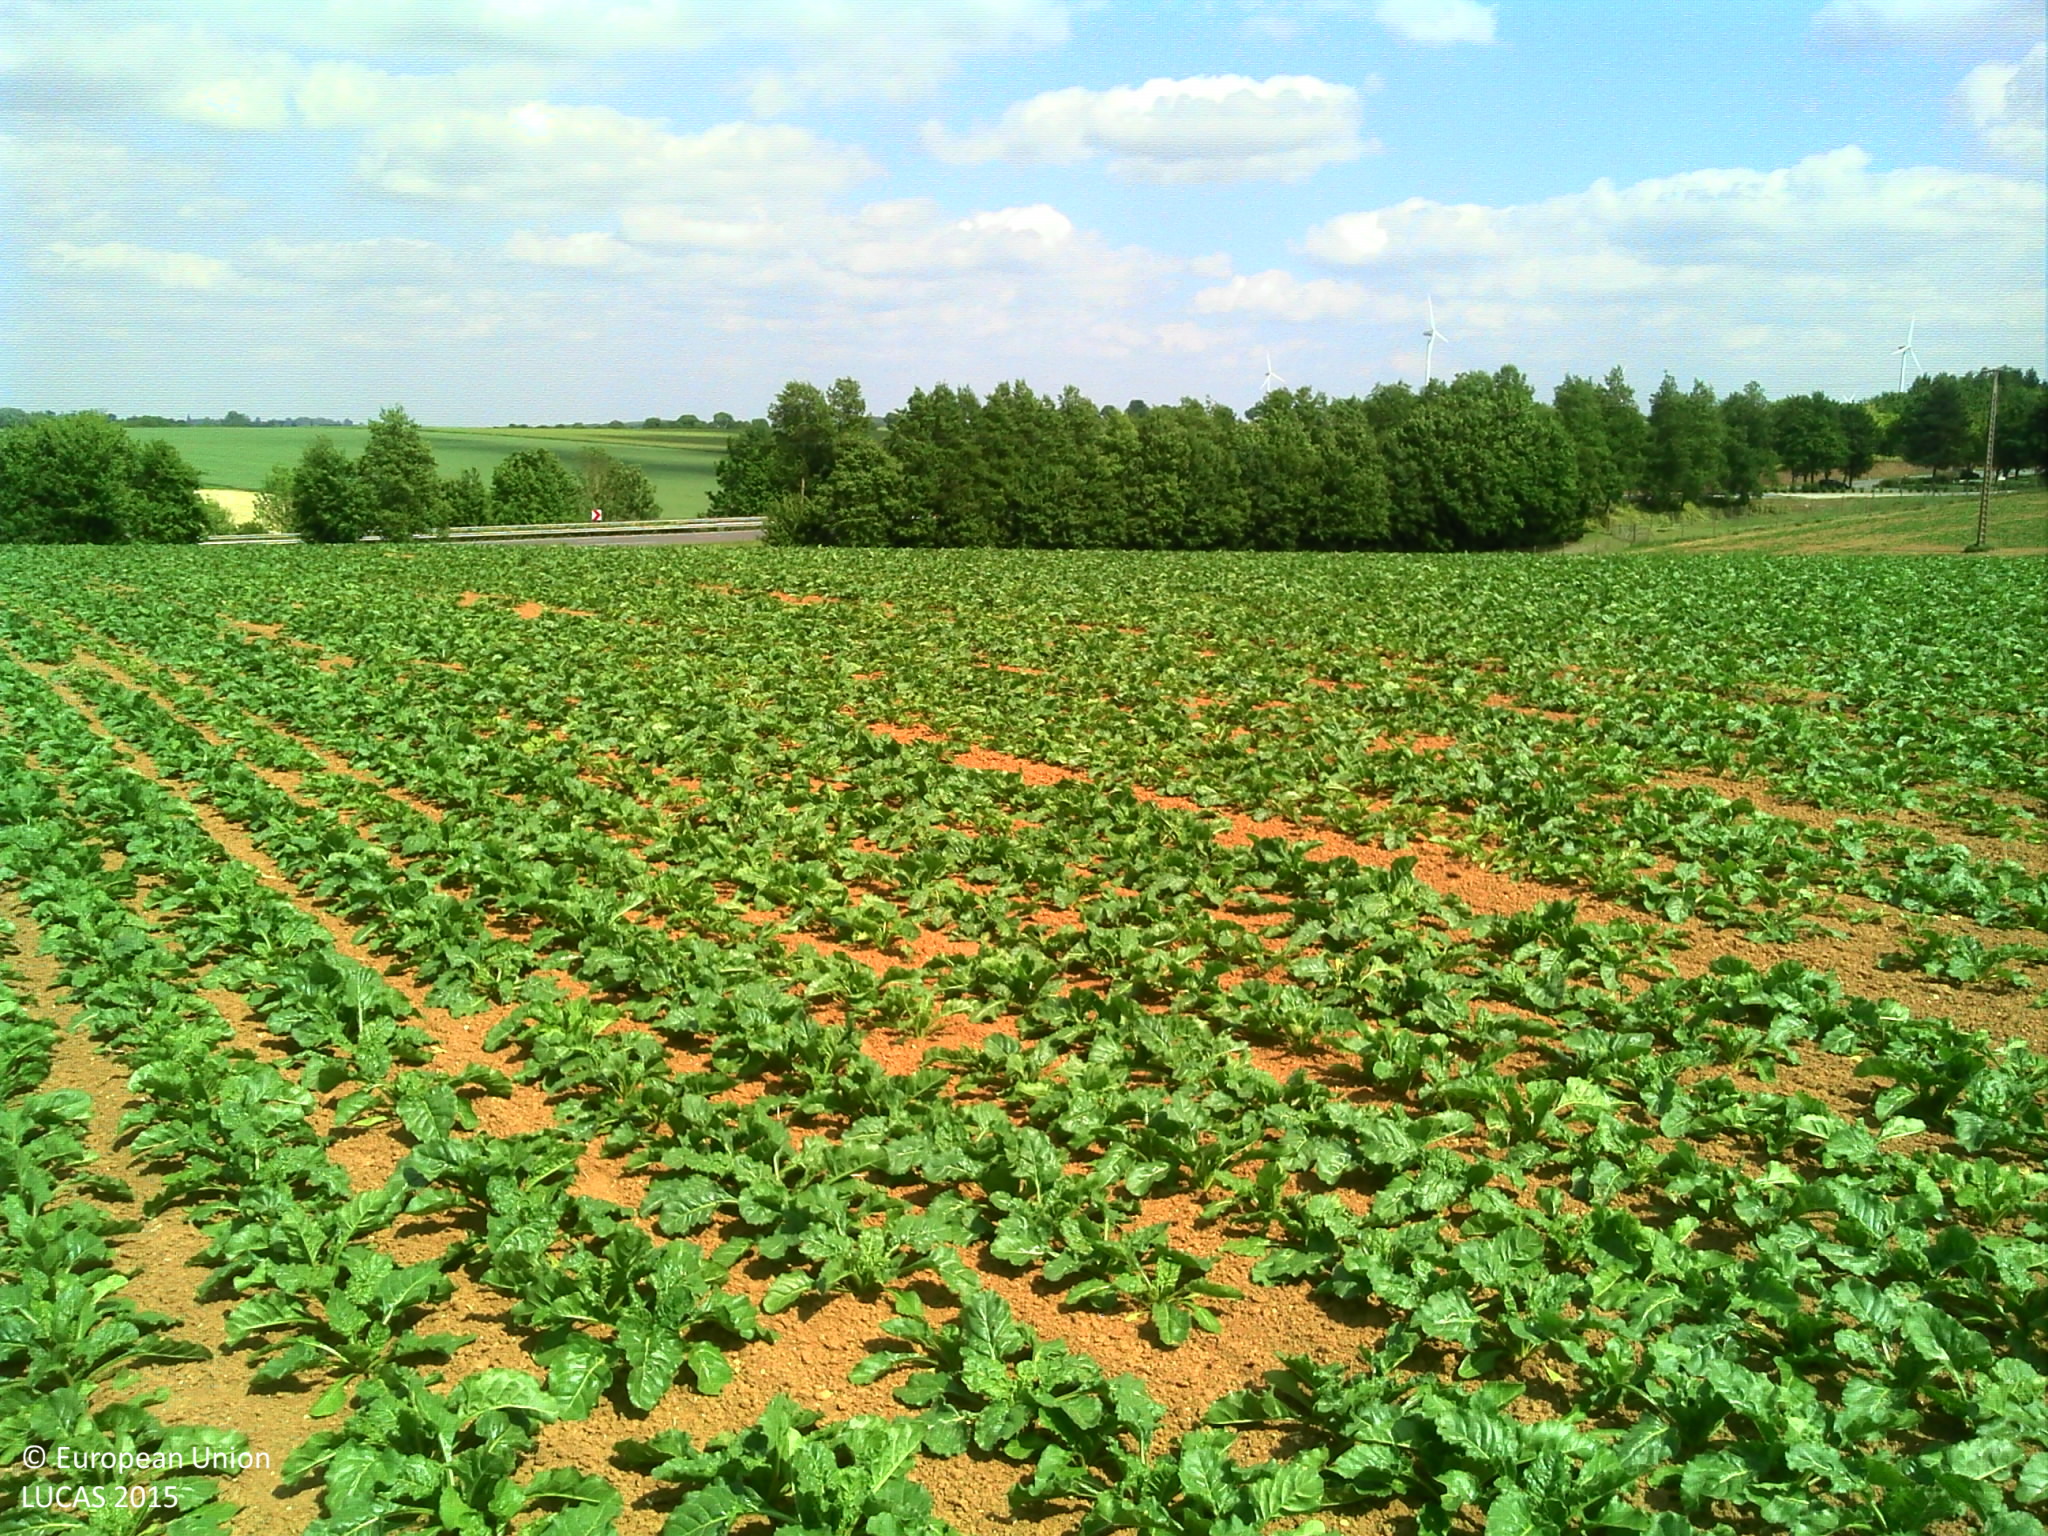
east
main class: Cropland
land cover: Sugar beet
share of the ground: > 75 %
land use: Agriculture (excluding fallow land and kitchen gardens)
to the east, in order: Sugar beet; Electric lines; Sugar beet; Spontaneously vegetated surfaces; Fences; Grass margins; Tracks; Ditches and canals; Spontaneously vegetated surfaces; Abandoned hedges; Paved roads, cycling and walking lanes; Electric lines; Paved roads, cycling and walking lanes; Abandoned hedges; Ditches and canals; Fences; Grassland without tree/shrub cover
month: May
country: FR
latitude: 49.9112
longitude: 3.2376
